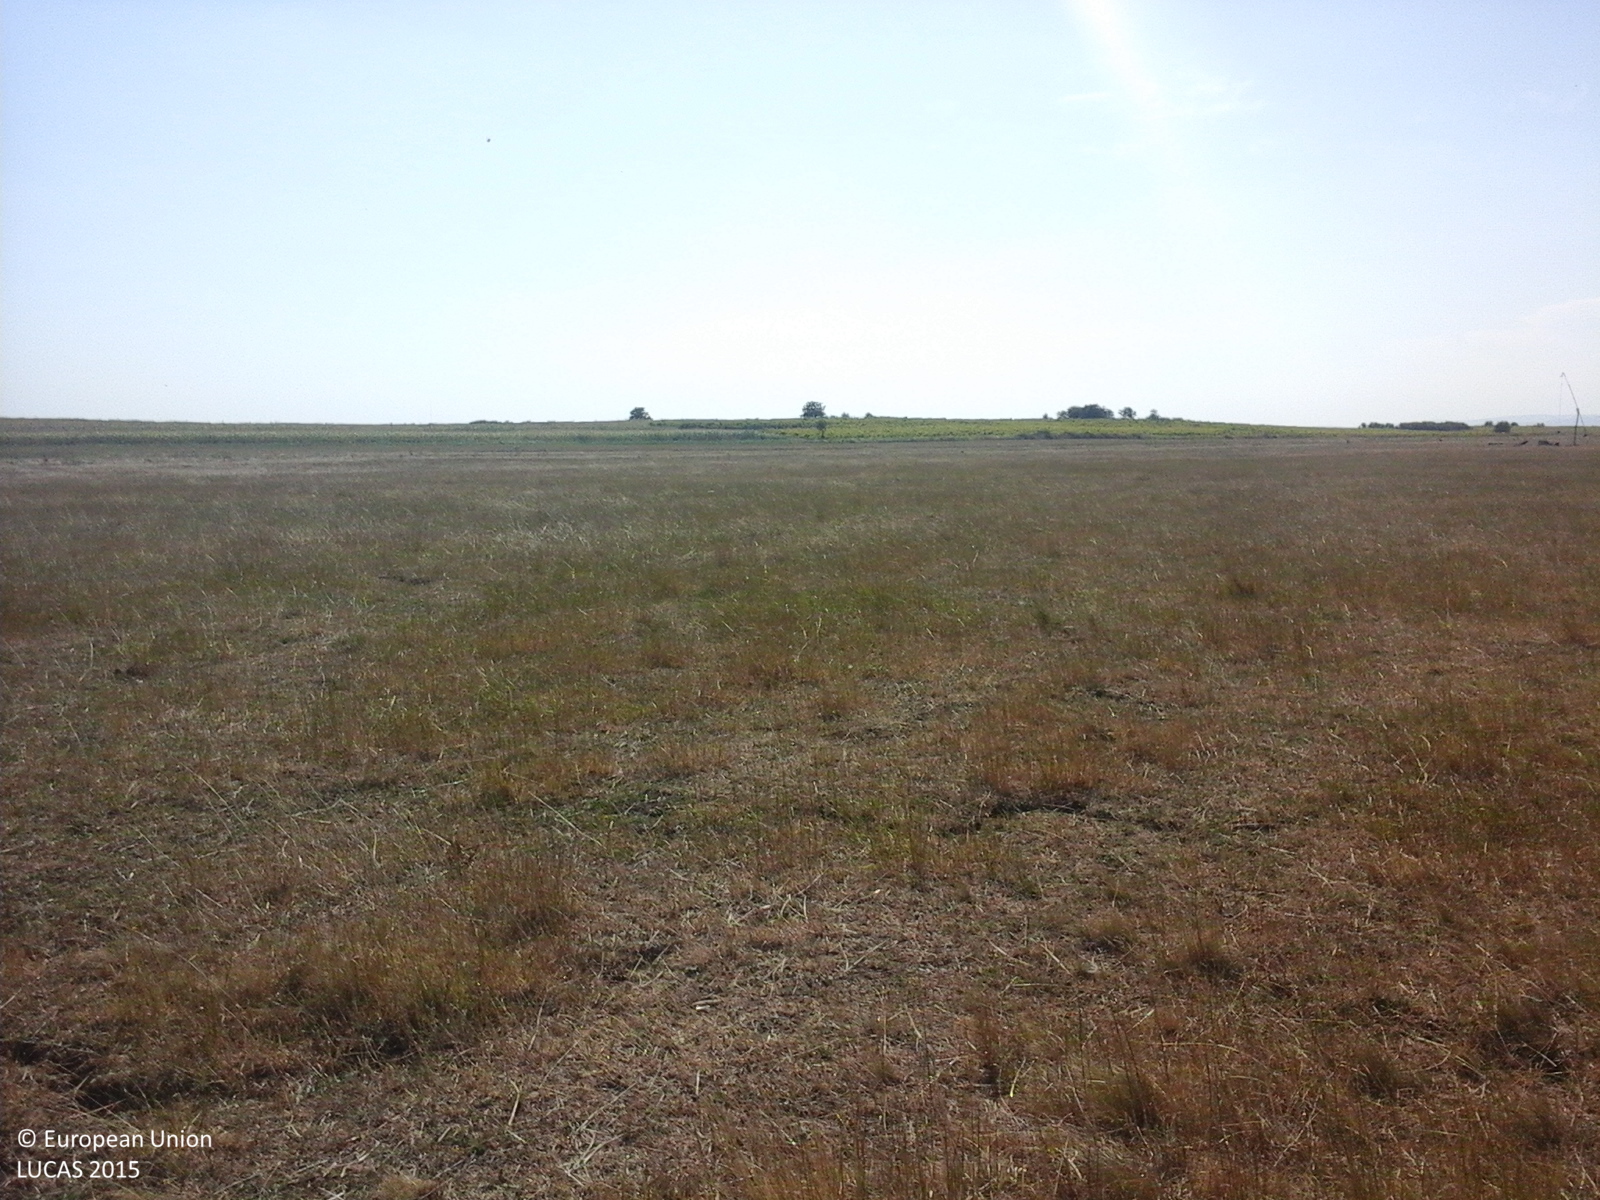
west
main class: Grassland
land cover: Grassland without tree/shrub cover
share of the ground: > 75 %
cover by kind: herbaceous plants 100 %
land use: Agriculture (excluding fallow land and kitchen gardens)
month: August
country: RO
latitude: 45.0349
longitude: 26.8739
